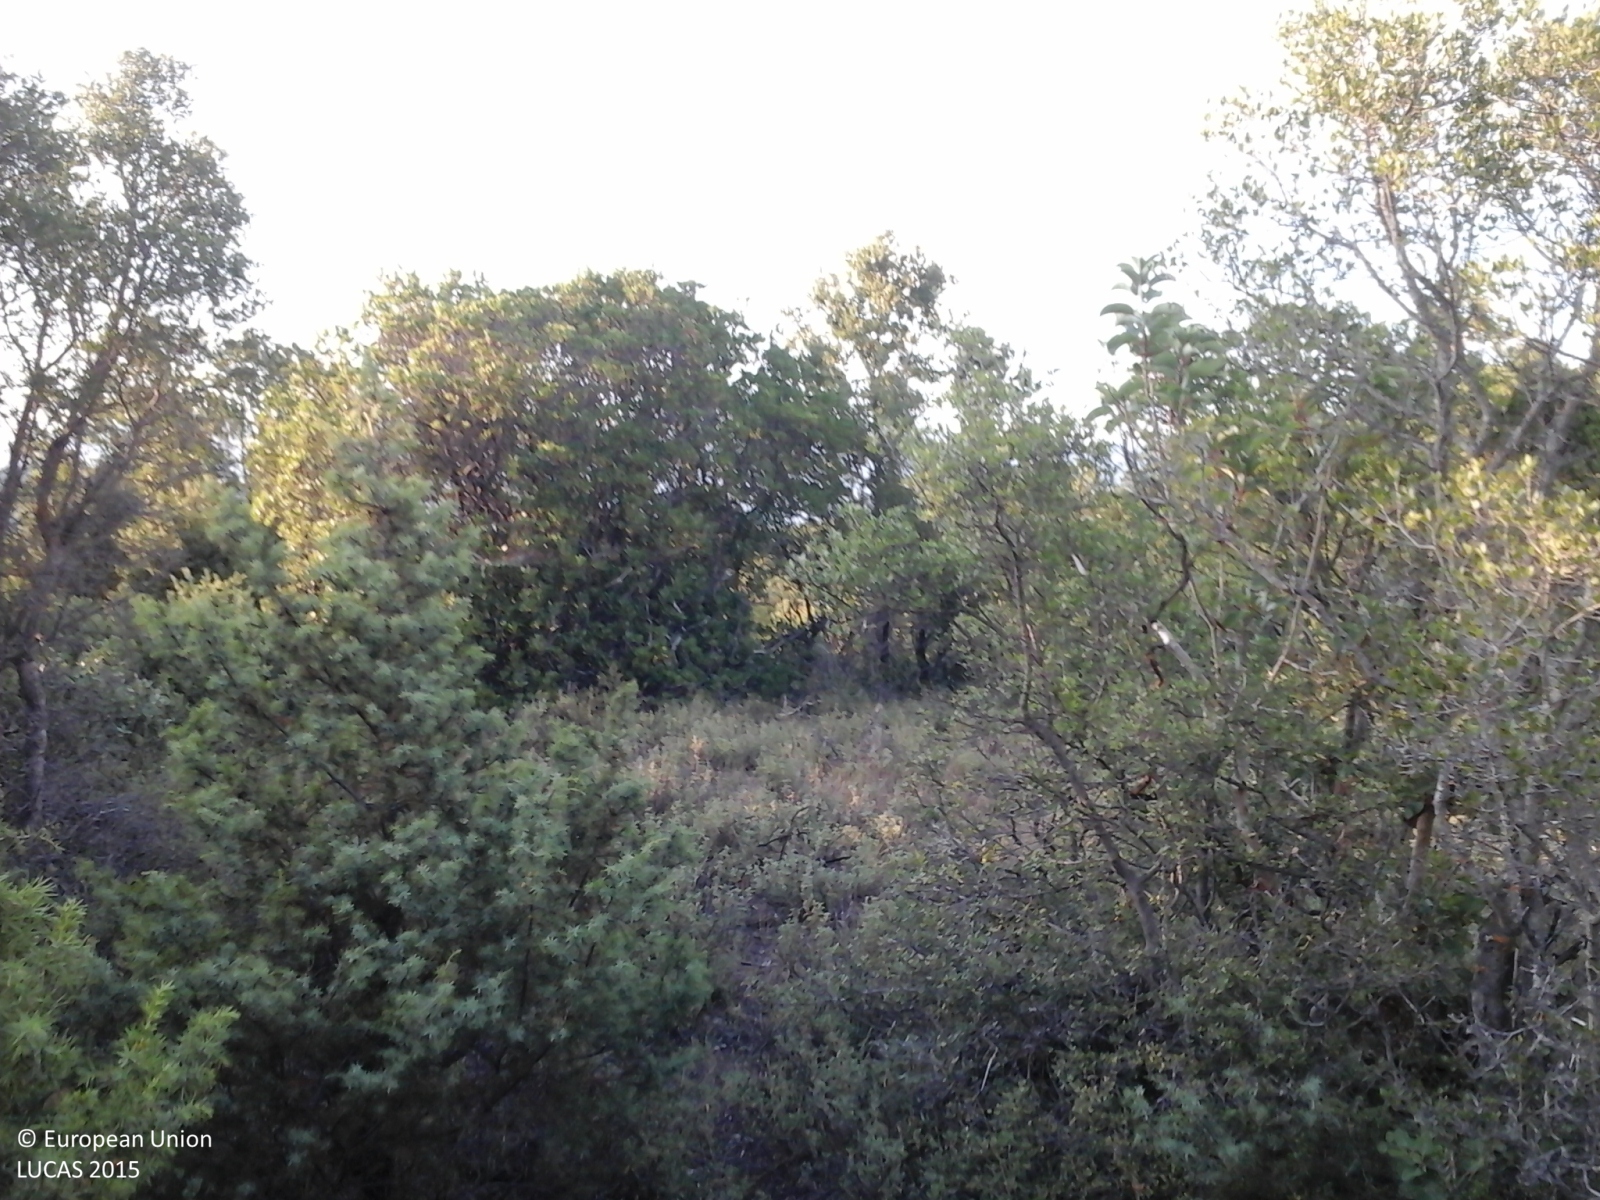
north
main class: Woodland
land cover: Broadleaved woodland
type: thermophilous deciduous forest
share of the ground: > 75 %
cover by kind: broadleaved forest trees 100 %
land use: Semi-natural and natural areas not in use
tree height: > 5 m
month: July
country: GR
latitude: 40.0649
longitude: 20.6860
